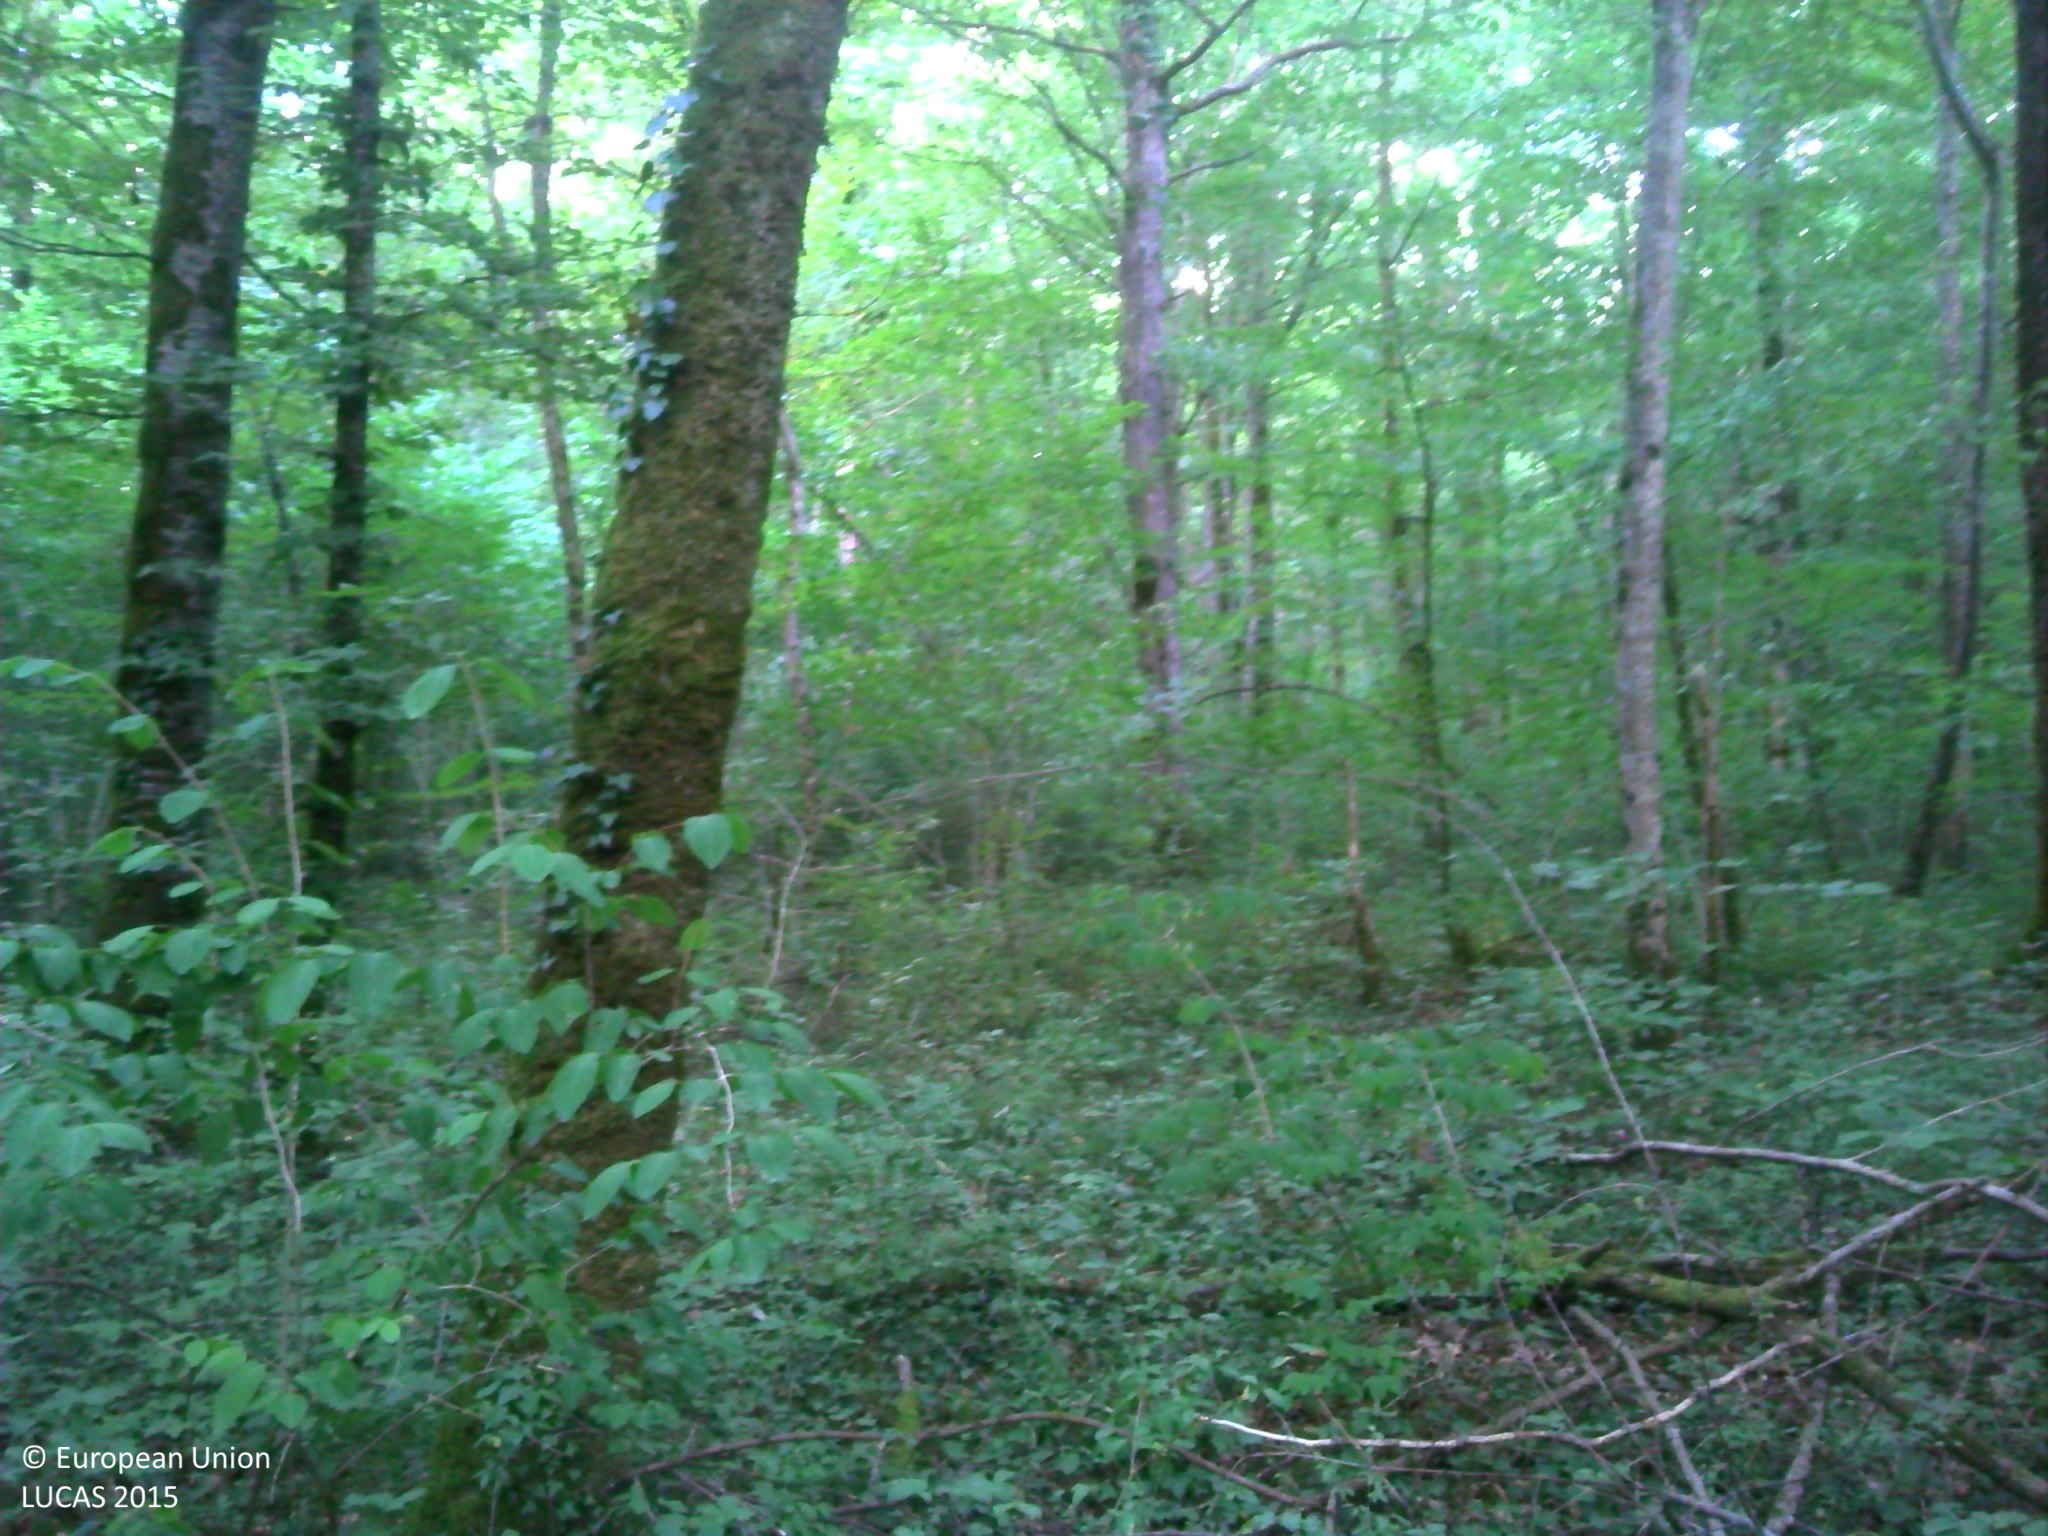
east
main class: Woodland
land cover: Broadleaved woodland
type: acidophilous oak and oak-birch forest
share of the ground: > 75 %
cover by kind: broadleaved forest trees 85 %, herbaceous plants 10 %, lichens and mosses 5 %
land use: Forestry
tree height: > 5 m
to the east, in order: Broadleaved woodland; Tracks; Broadleaved woodland
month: July
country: FR
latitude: 47.8751
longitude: 4.9854
